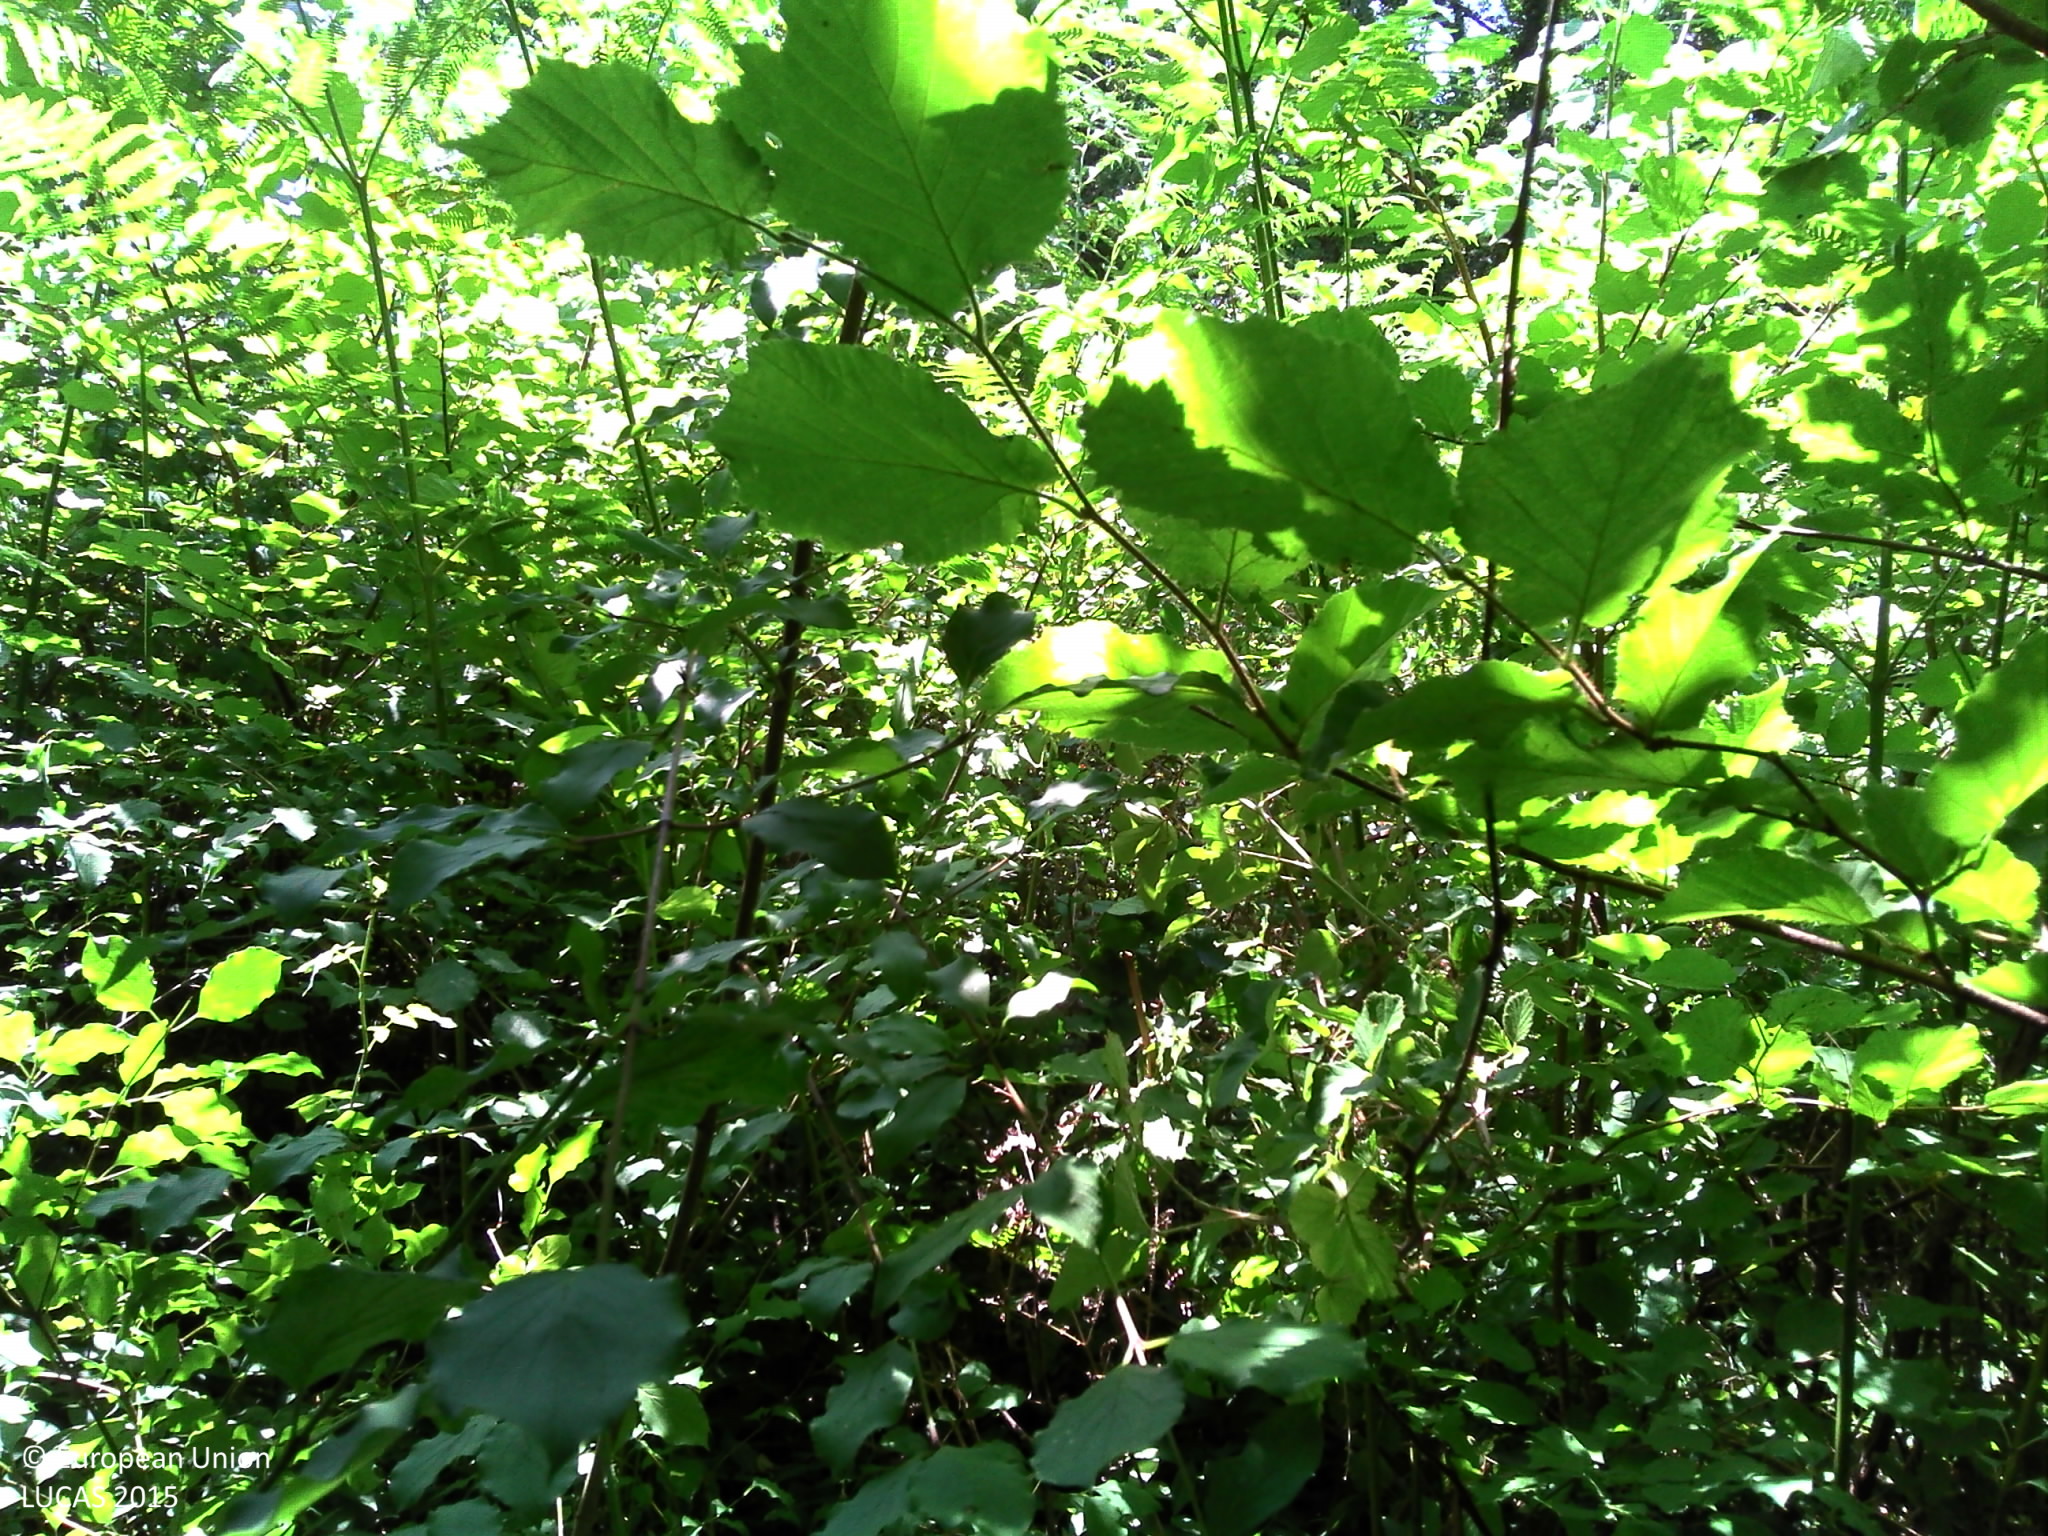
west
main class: Woodland
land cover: Broadleaved woodland
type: mesophytic deciduous forest
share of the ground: > 75 %
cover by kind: broadleaved forest trees 80 %, herbaceous plants 15 %, shrubs 5 %
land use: Forestry
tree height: > 5 m
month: June
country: FR
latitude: 45.6085
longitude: 0.3817
